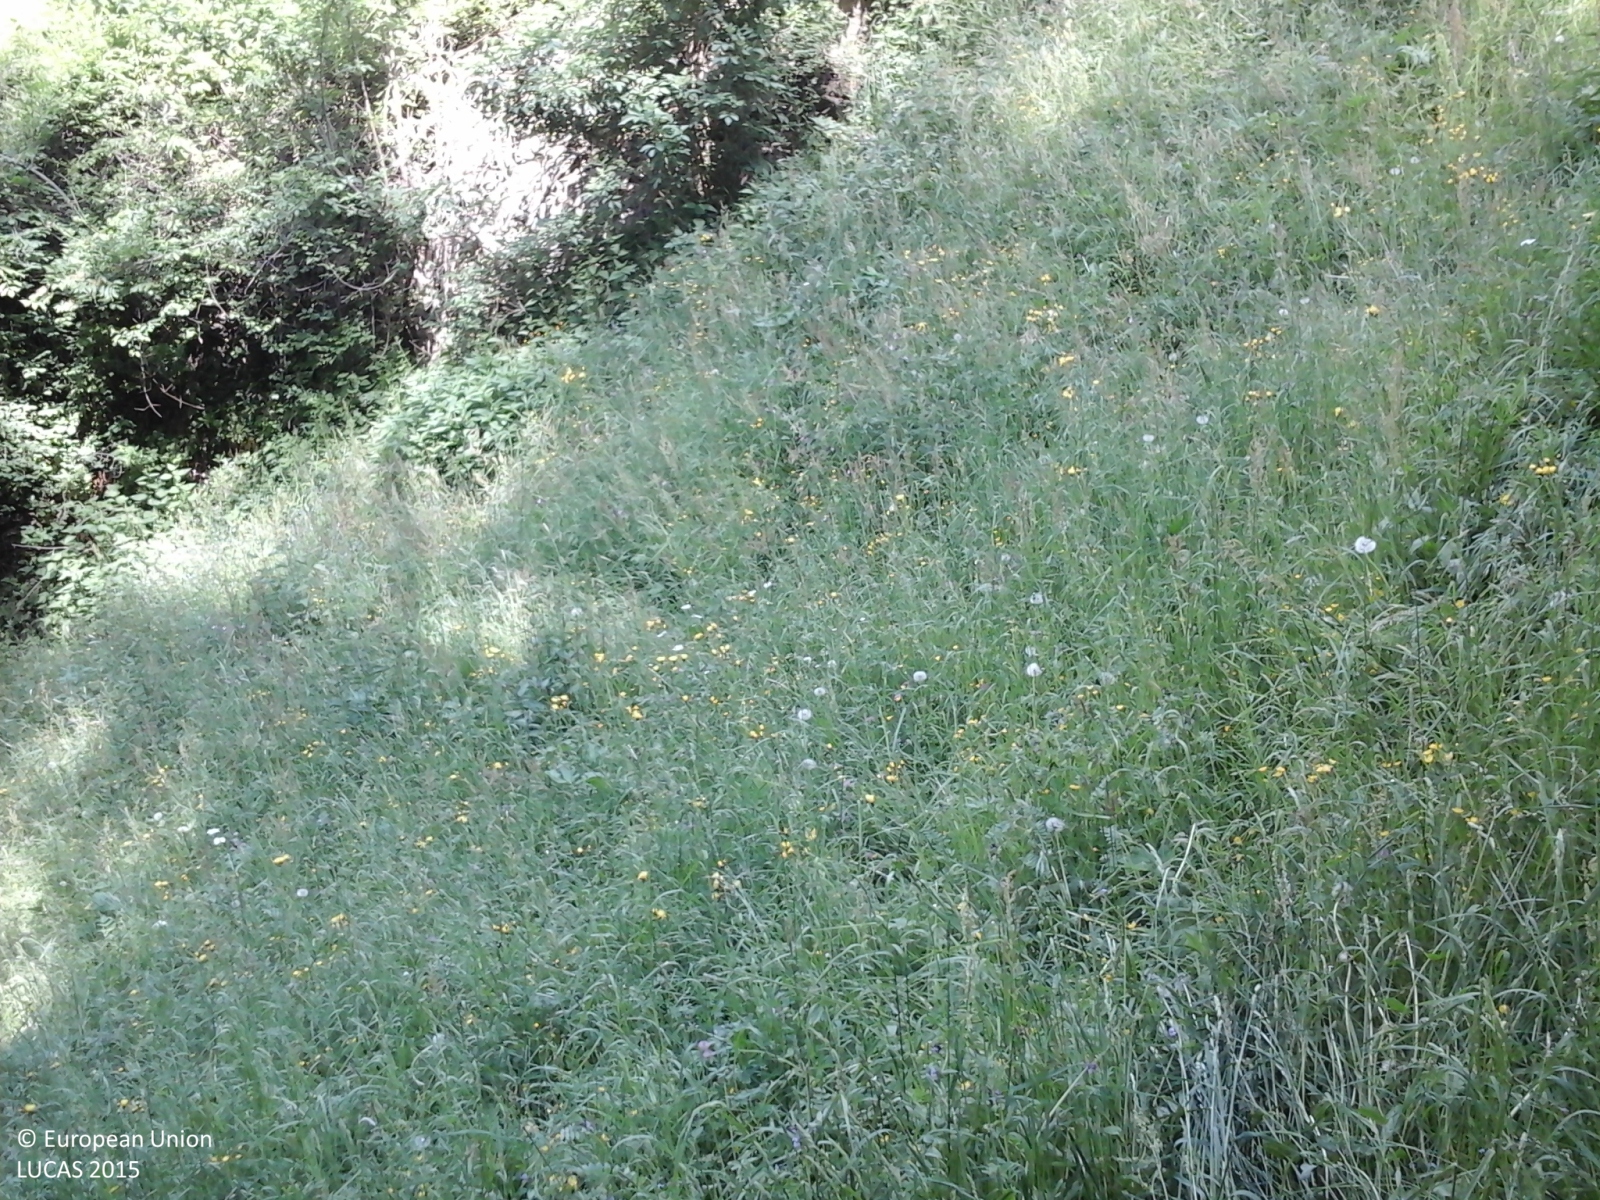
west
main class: Woodland
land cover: Broadleaved woodland
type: mesophytic deciduous forest
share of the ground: > 75 %
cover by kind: broadleaved forest trees 100 %
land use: Forestry
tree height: > 5 m
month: June
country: IT
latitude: 46.6712
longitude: 10.9531
